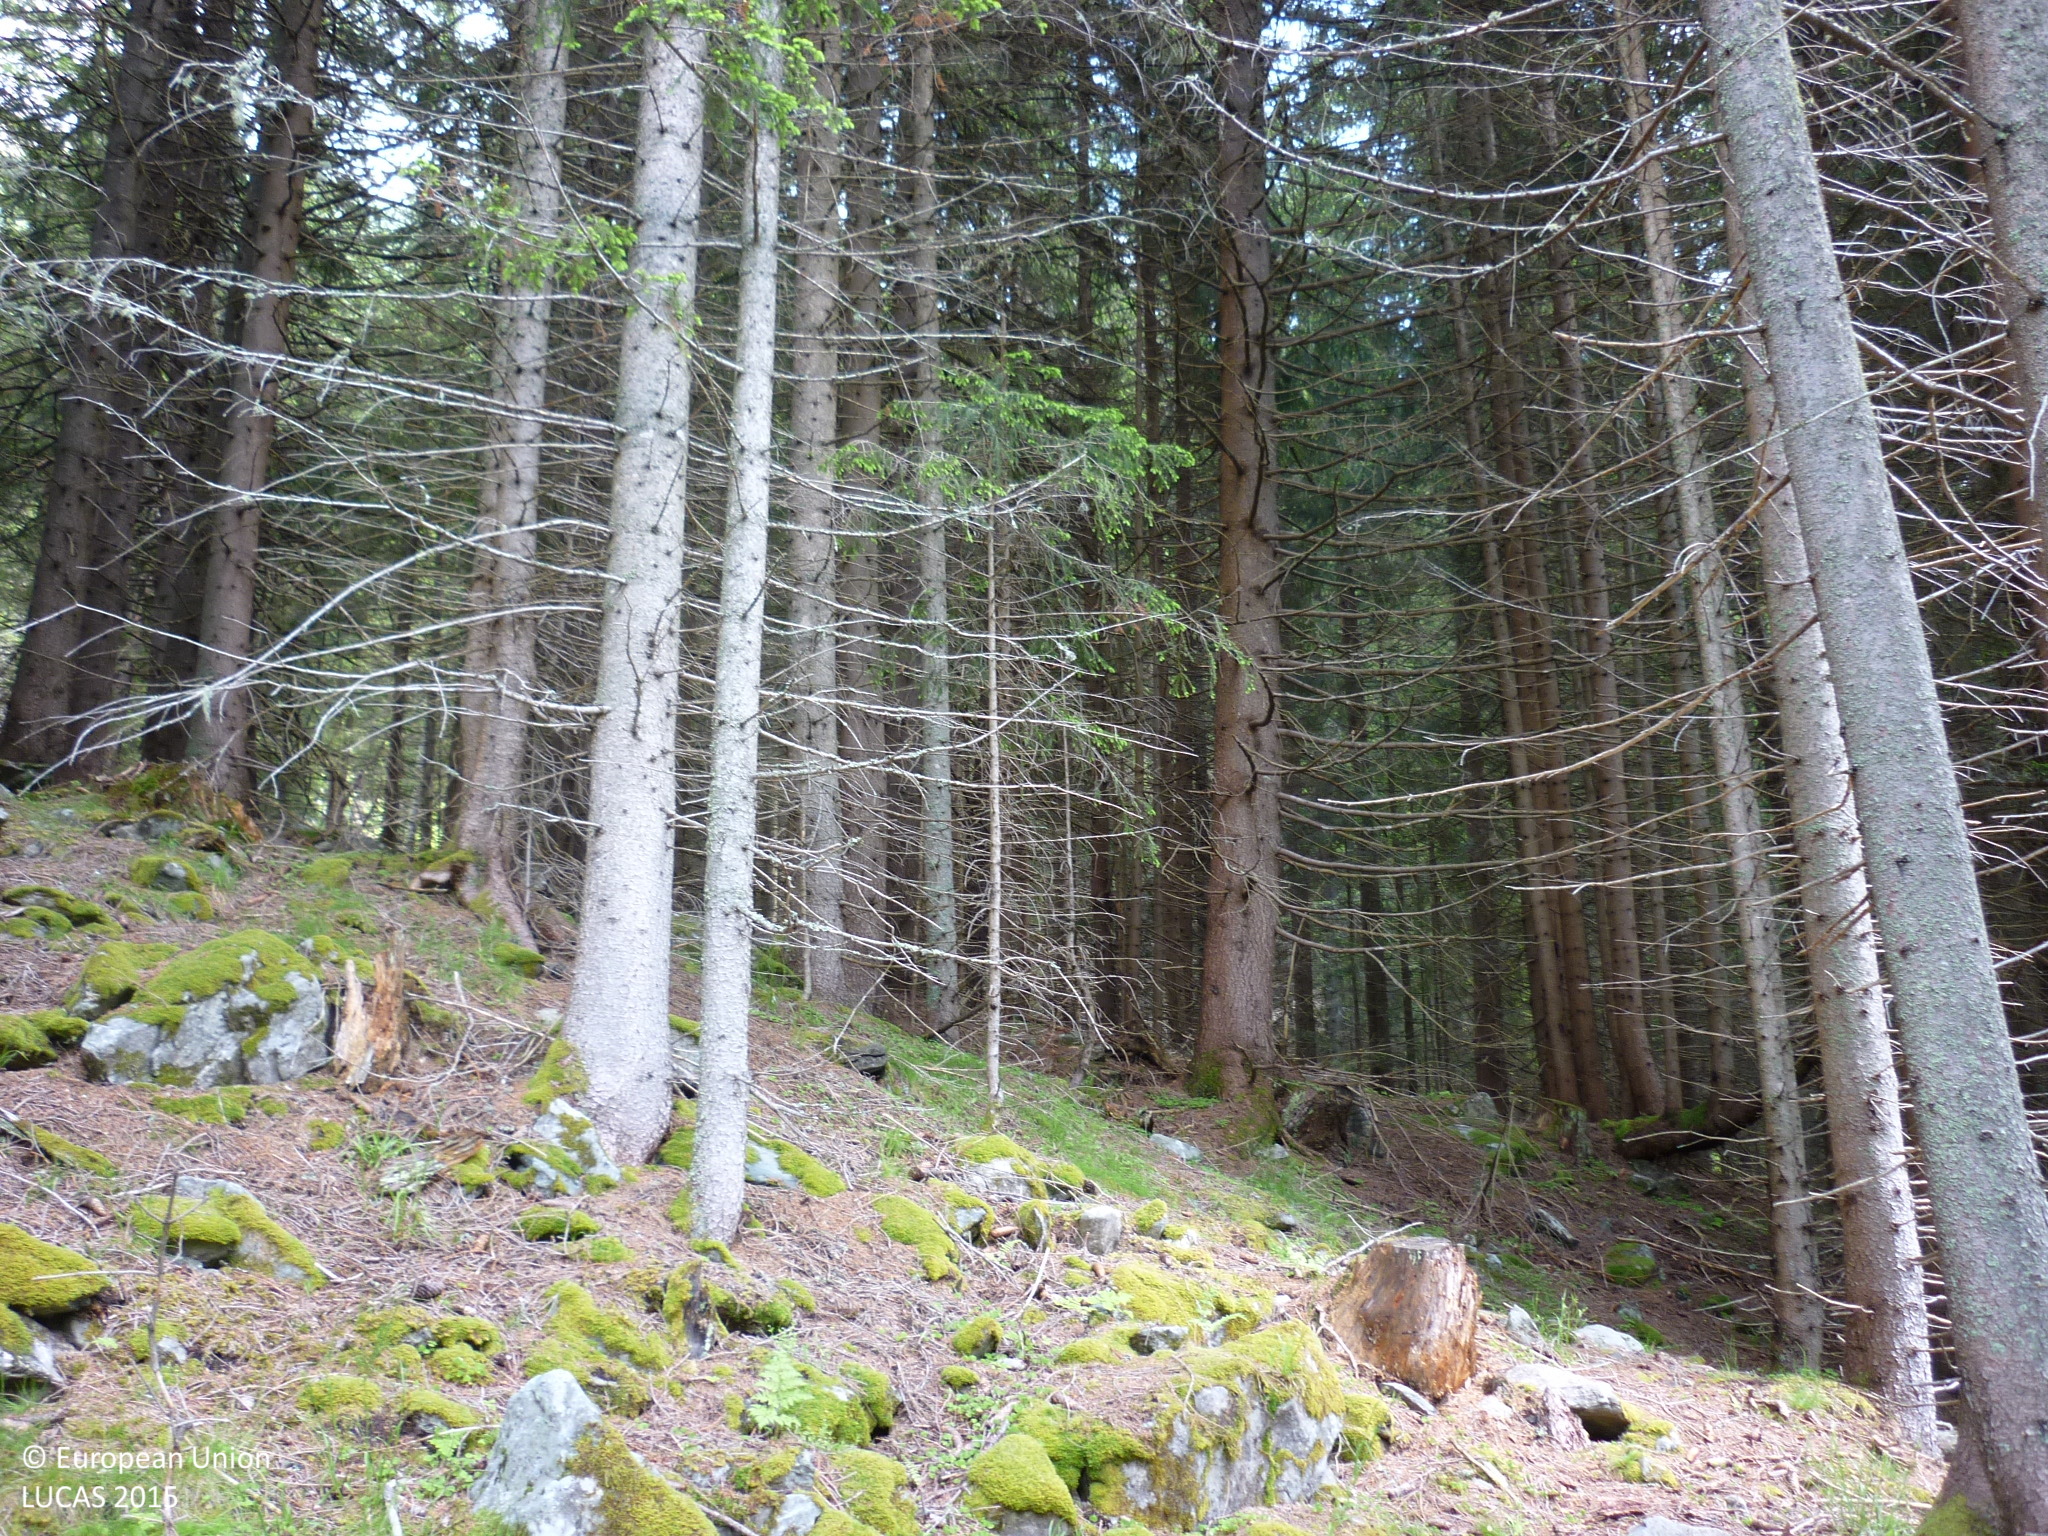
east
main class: Woodland
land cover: Spruce dominated coniferous woodland
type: alpine coniferous forest
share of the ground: > 75 %
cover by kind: coniferous forest trees 90 %, herbaceous plants 5 %, lichens and mosses 5 %
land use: Forestry
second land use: Amenities, museums, leisure
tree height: > 5 m
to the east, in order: Spruce dominated coniferous woodland; Spontaneously vegetated surfaces; Tracks; Spruce dominated coniferous woodland; Rivers and streams; Other mixed woodland; Grass margins; Tracks; Grassland with sparse tree/shrub cover; Spruce dominated coniferous woodland
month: June
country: AT
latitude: 47.2329
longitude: 13.9740
